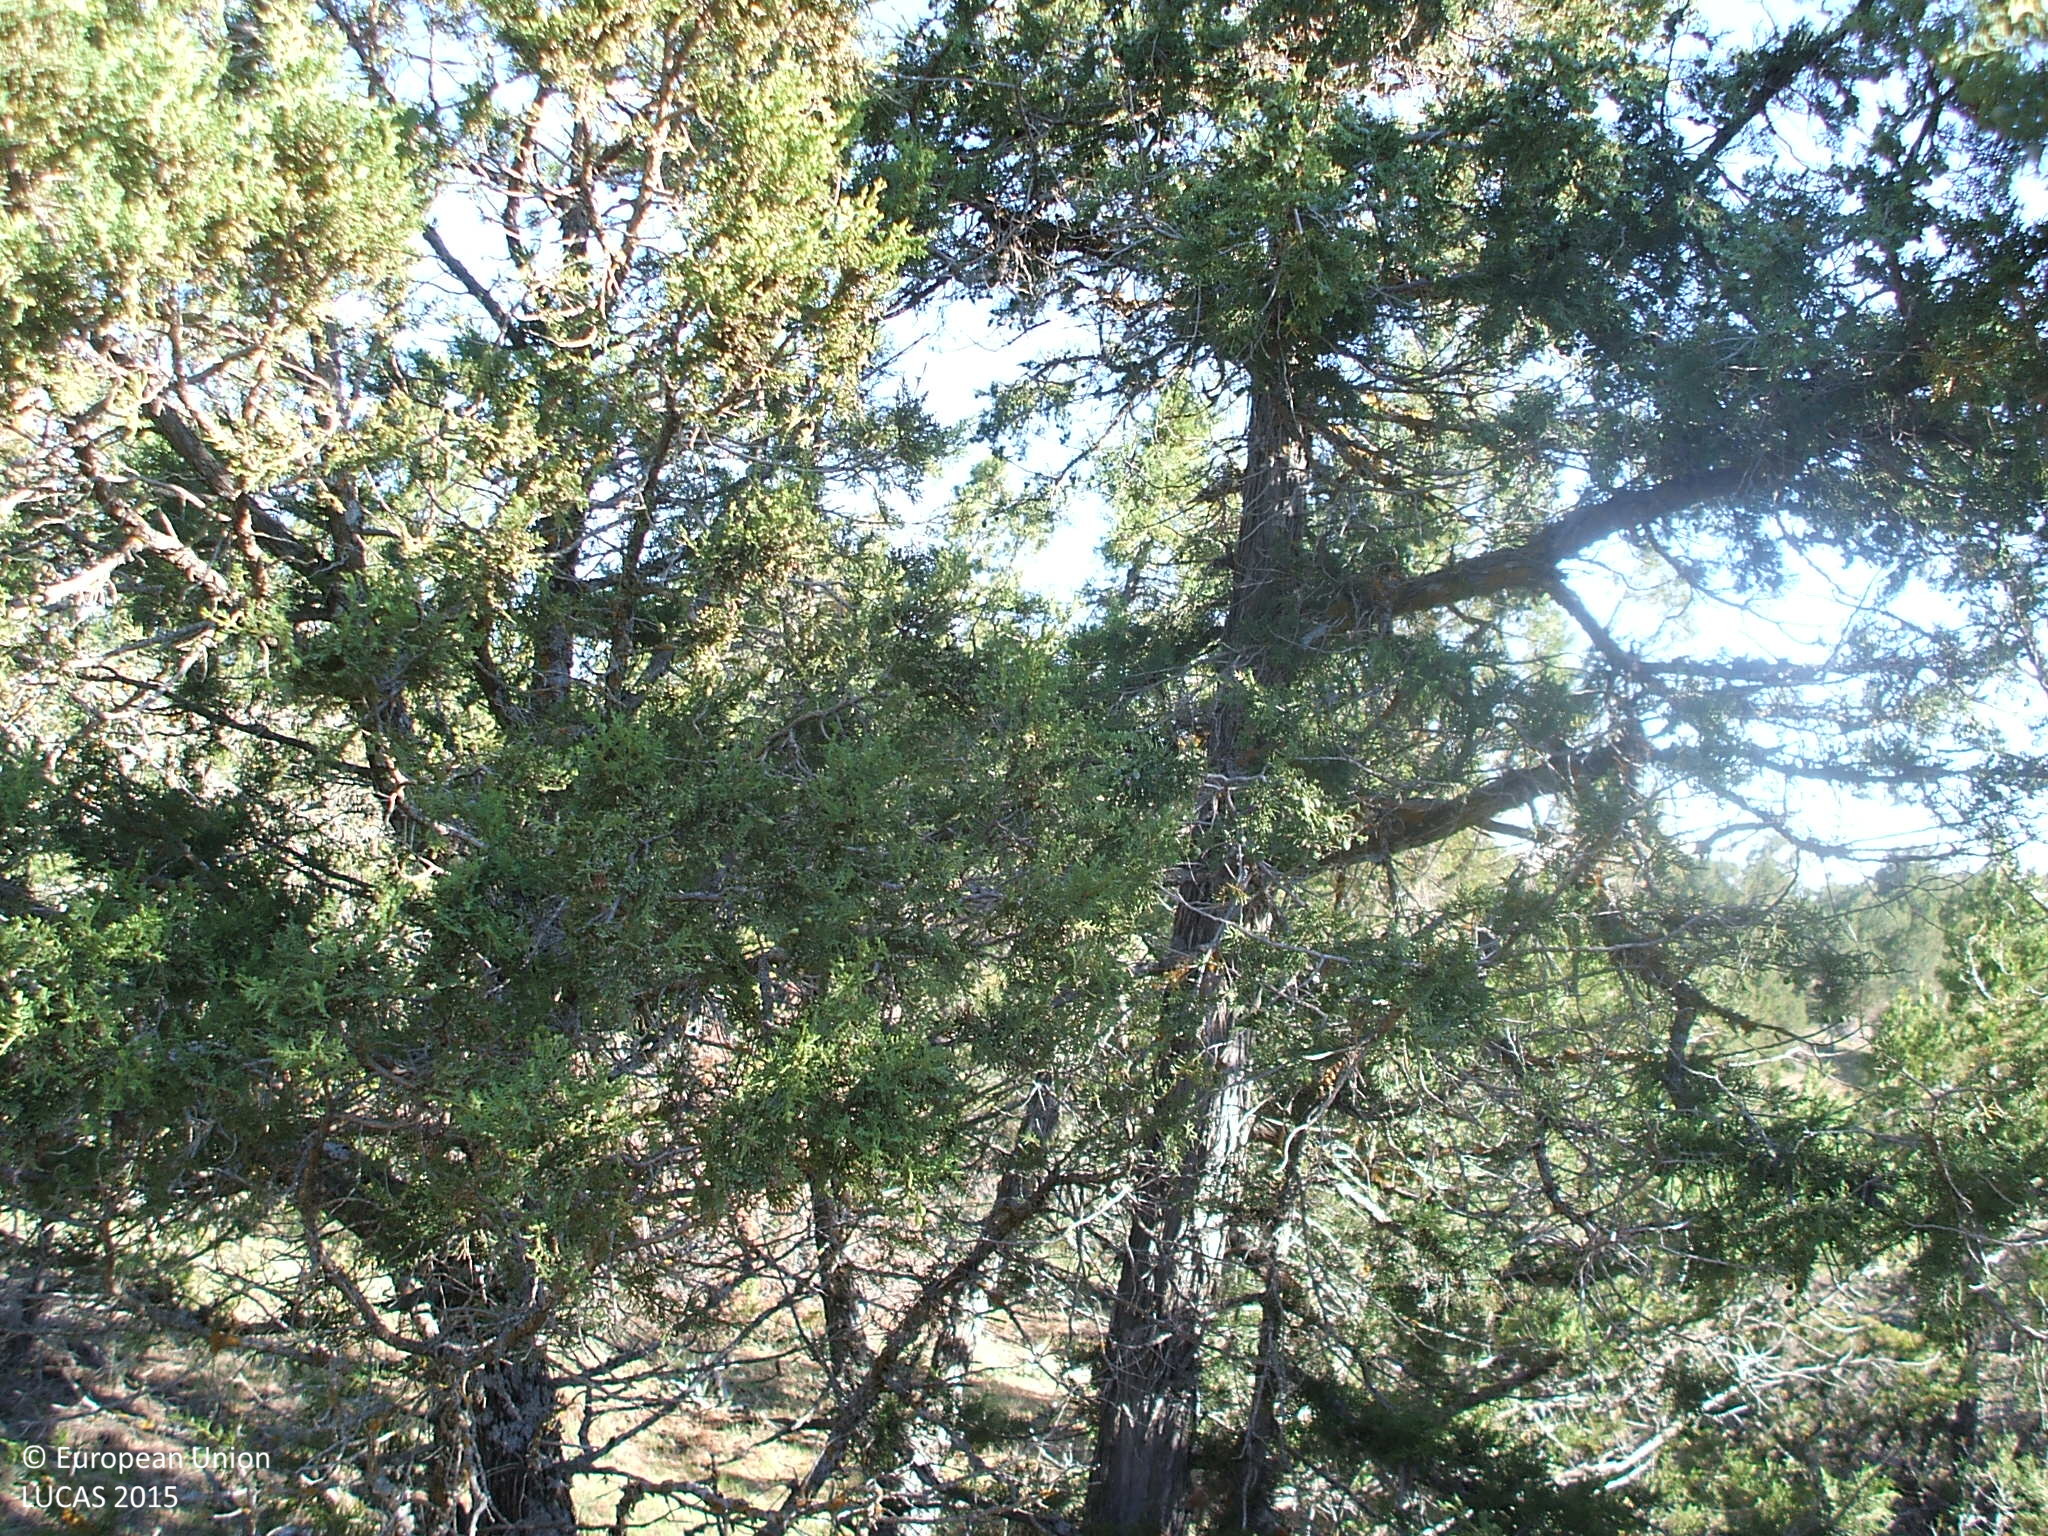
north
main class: Woodland
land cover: Other coniferous woodland
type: coniferous forest of the mediterranean region
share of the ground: 50 - 75 %
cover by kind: coniferous forest trees 60 %, herbaceous plants 40 %
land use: Semi-natural and natural areas not in use
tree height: > 5 m
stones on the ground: > 50 %
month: May
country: ES
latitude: 40.1440
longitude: -0.9591
